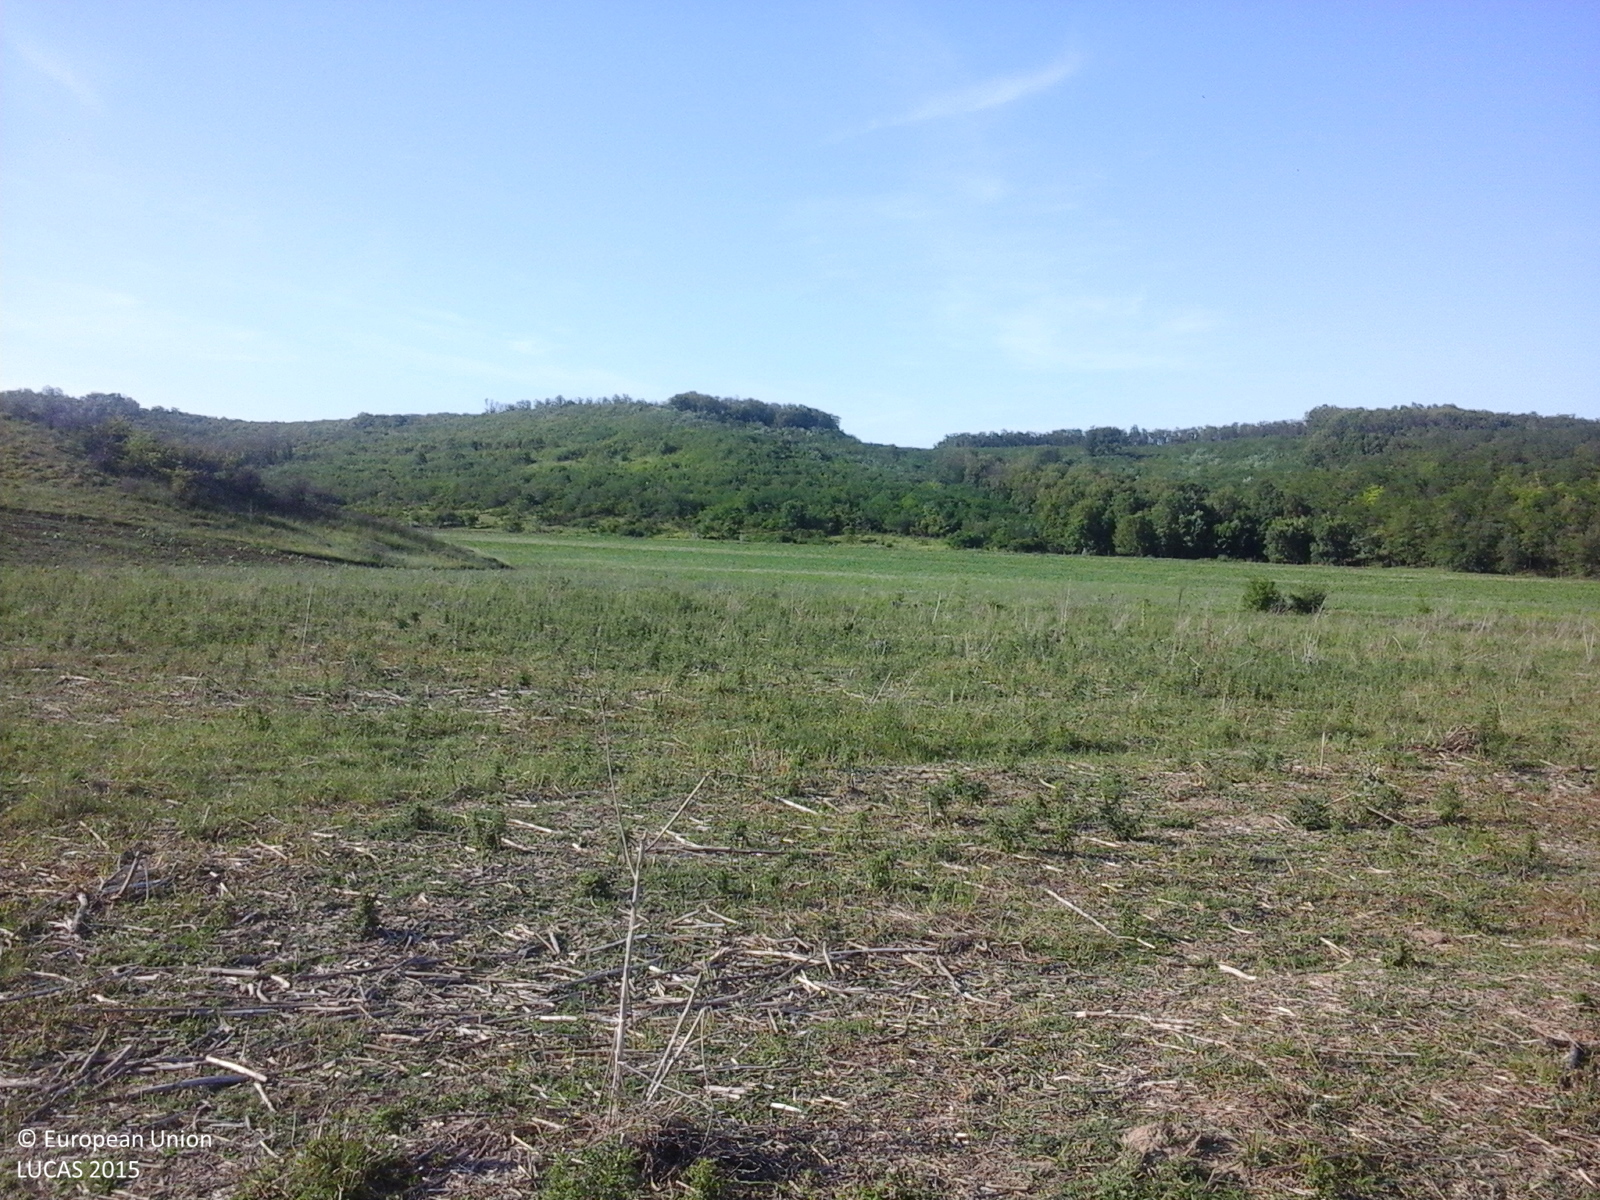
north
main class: Grassland
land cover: Spontaneously vegetated surfaces
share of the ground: > 75 %
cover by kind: herbaceous plants 100 %
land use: Agriculture (excluding fallow land and kitchen gardens)
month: June
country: RO
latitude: 47.1269
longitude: 27.0139
